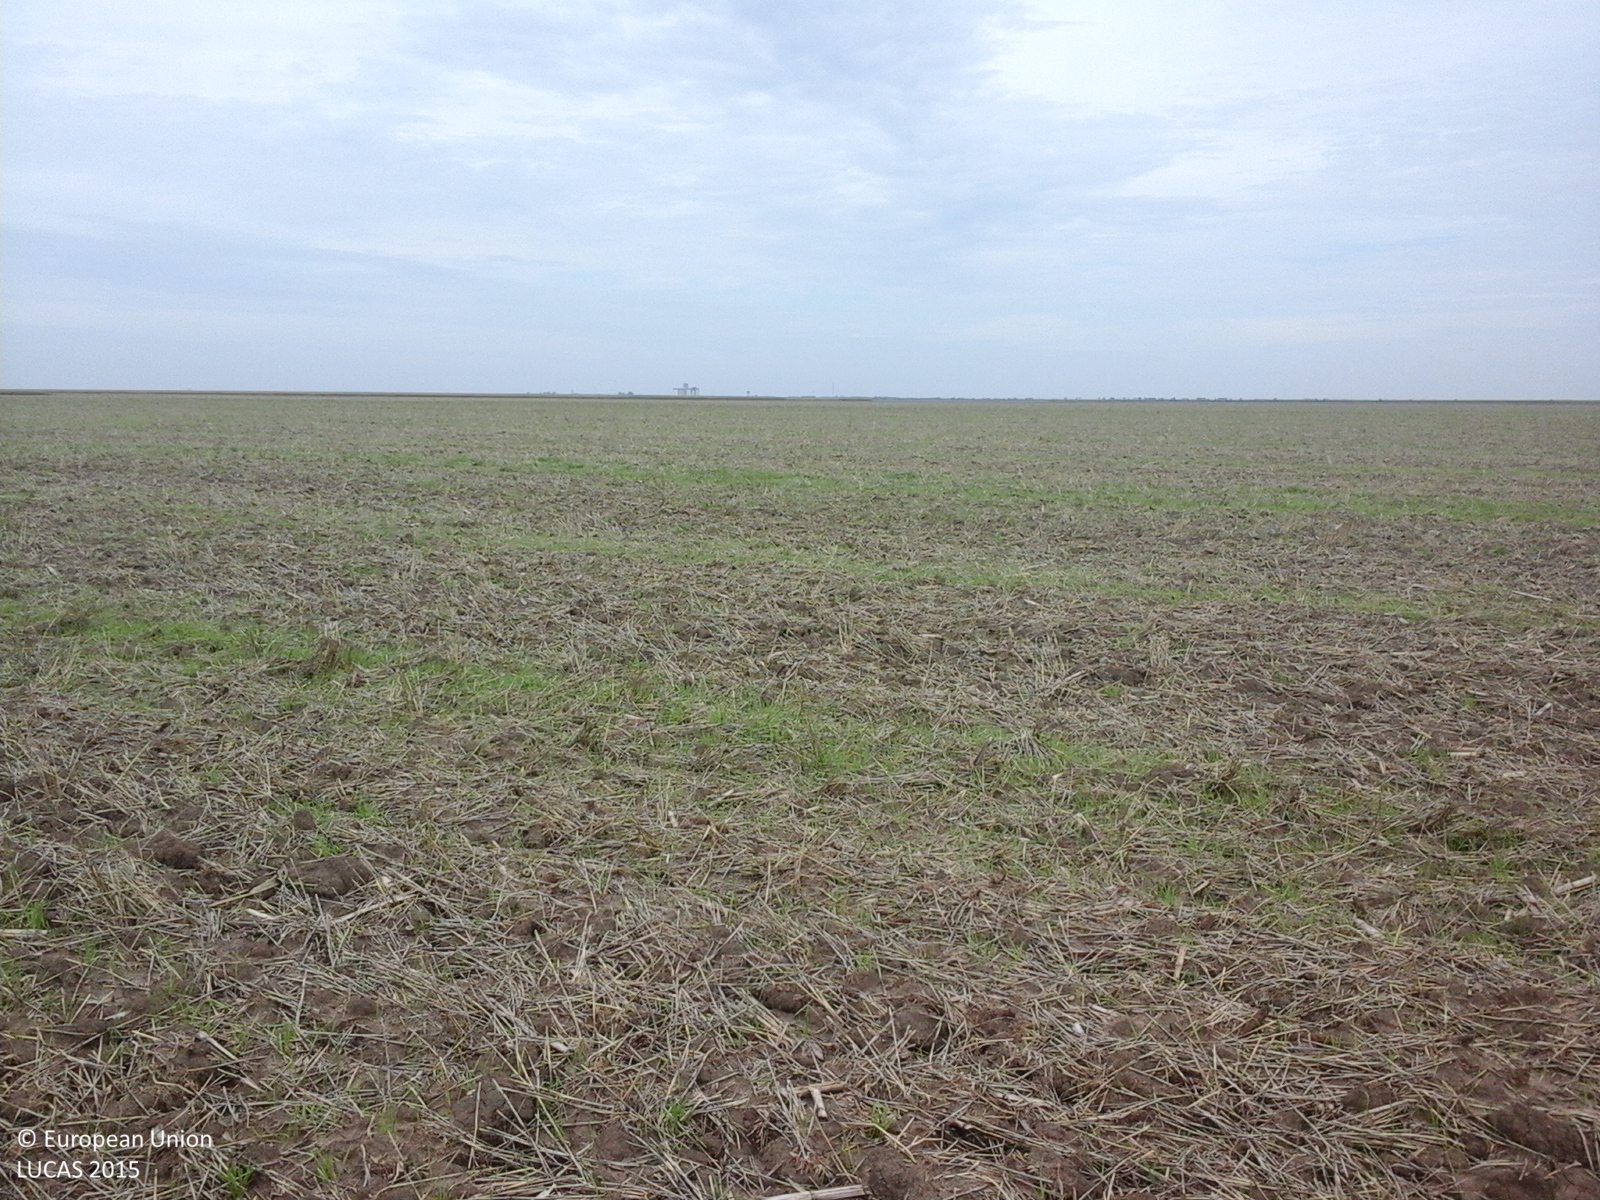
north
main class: Cropland
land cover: Common wheat
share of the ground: 25 - 50 %
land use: Agriculture (excluding fallow land and kitchen gardens)
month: August
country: RO
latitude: 46.2870
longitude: 21.5503
